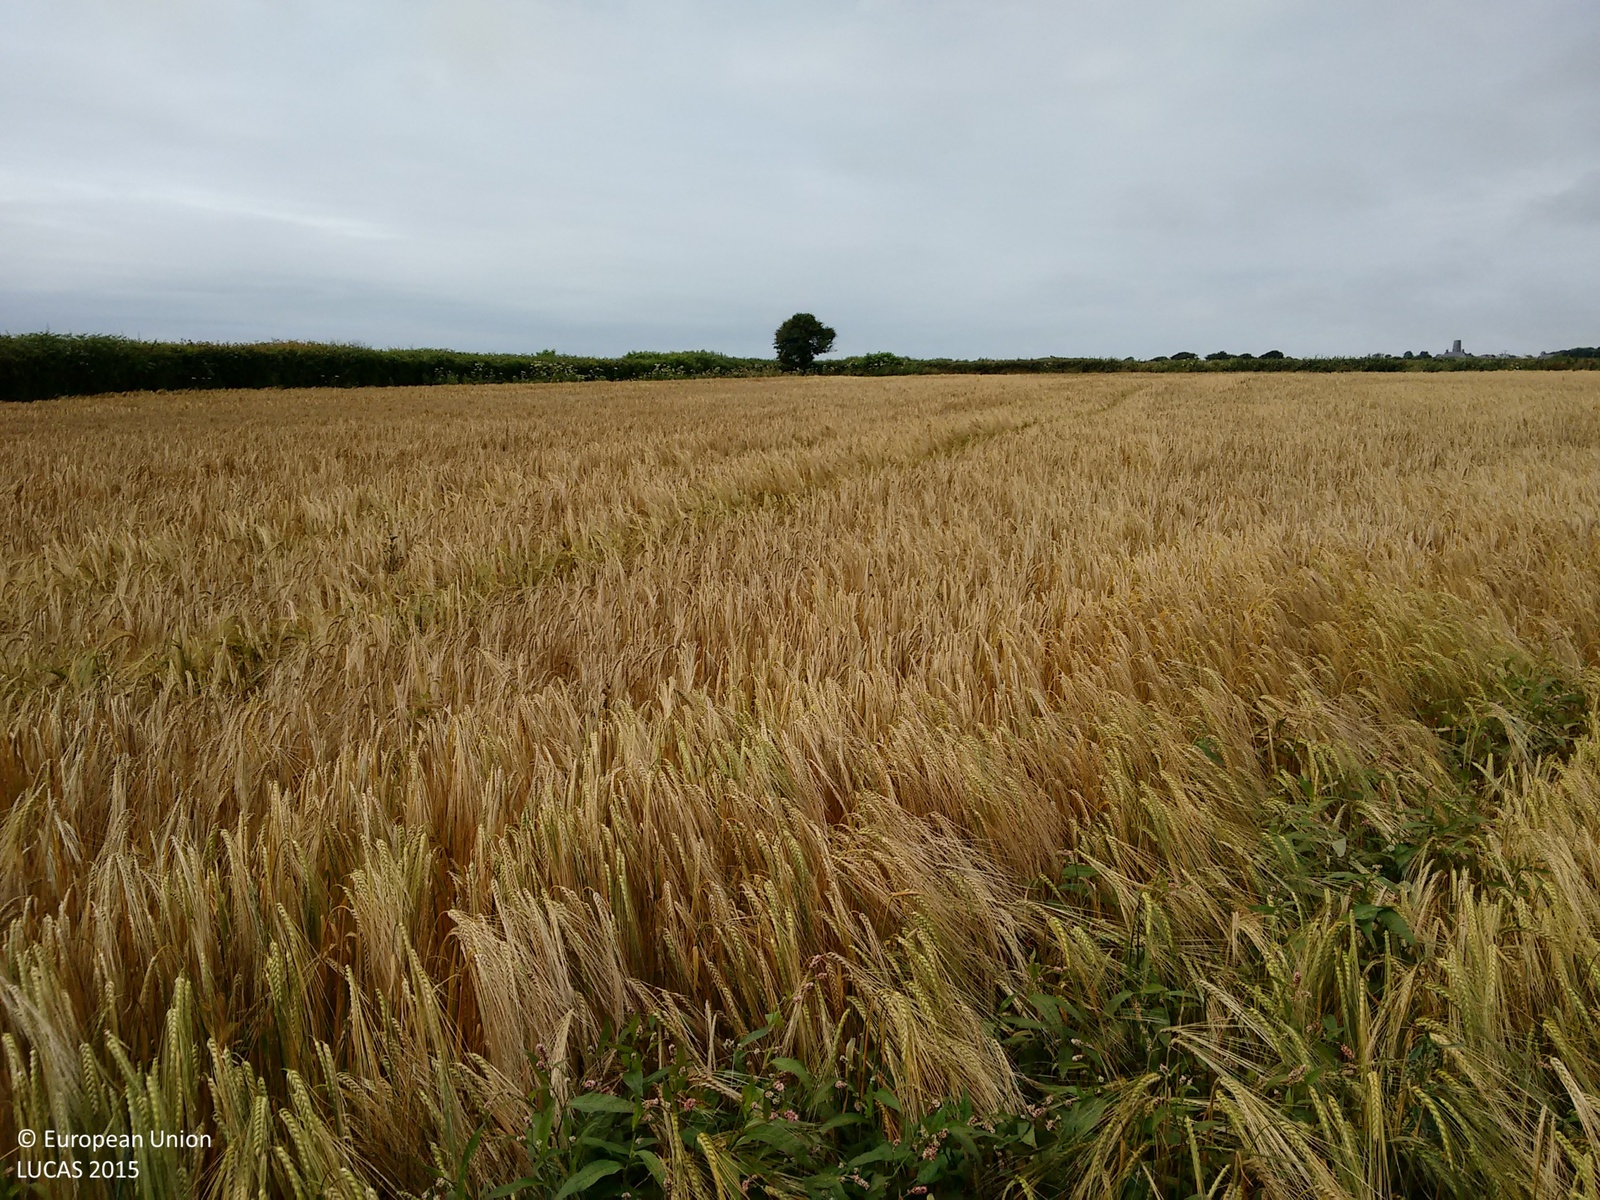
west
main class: Cropland
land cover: Barley
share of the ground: > 75 %
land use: Agriculture (excluding fallow land and kitchen gardens)
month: July
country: GB
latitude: 51.4334
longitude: -3.5346
